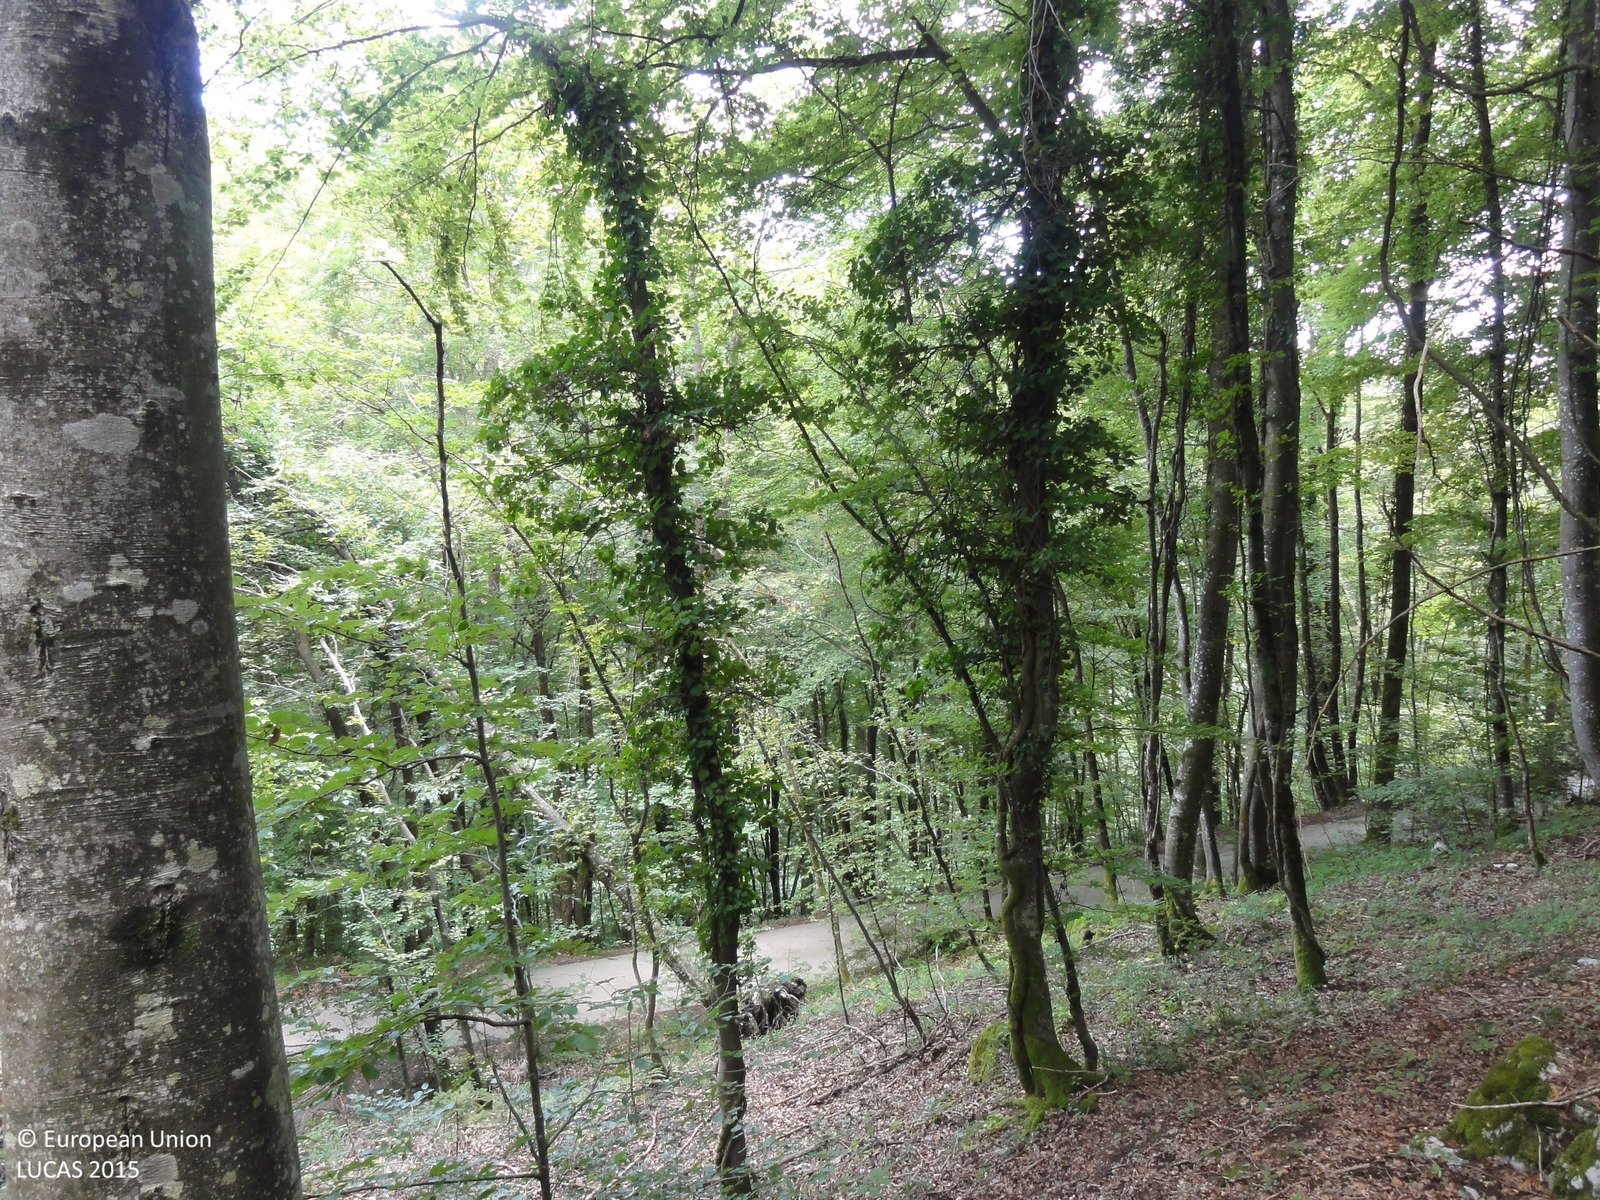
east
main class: Woodland
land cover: Broadleaved woodland
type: beech forest
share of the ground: > 75 %
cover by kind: broadleaved forest trees 100 %
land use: Forestry
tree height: > 5 m
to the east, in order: Broadleaved woodland; Paved roads, cycling and walking lanes; Broadleaved woodland; Rivers and streams; Grassland without tree/shrub cover; Electric lines; Grassland without tree/shrub cover; Rivers and streams; Spruce dominated mixed woodland; Tracks; Spruce dominated mixed woodland; Tracks; Spruce dominated mixed woodland; Broadleaved woodland; Tracks; Broadleaved woodland; Tracks; Broadleaved woodland
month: September
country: SI
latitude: 45.9040
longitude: 15.1141
